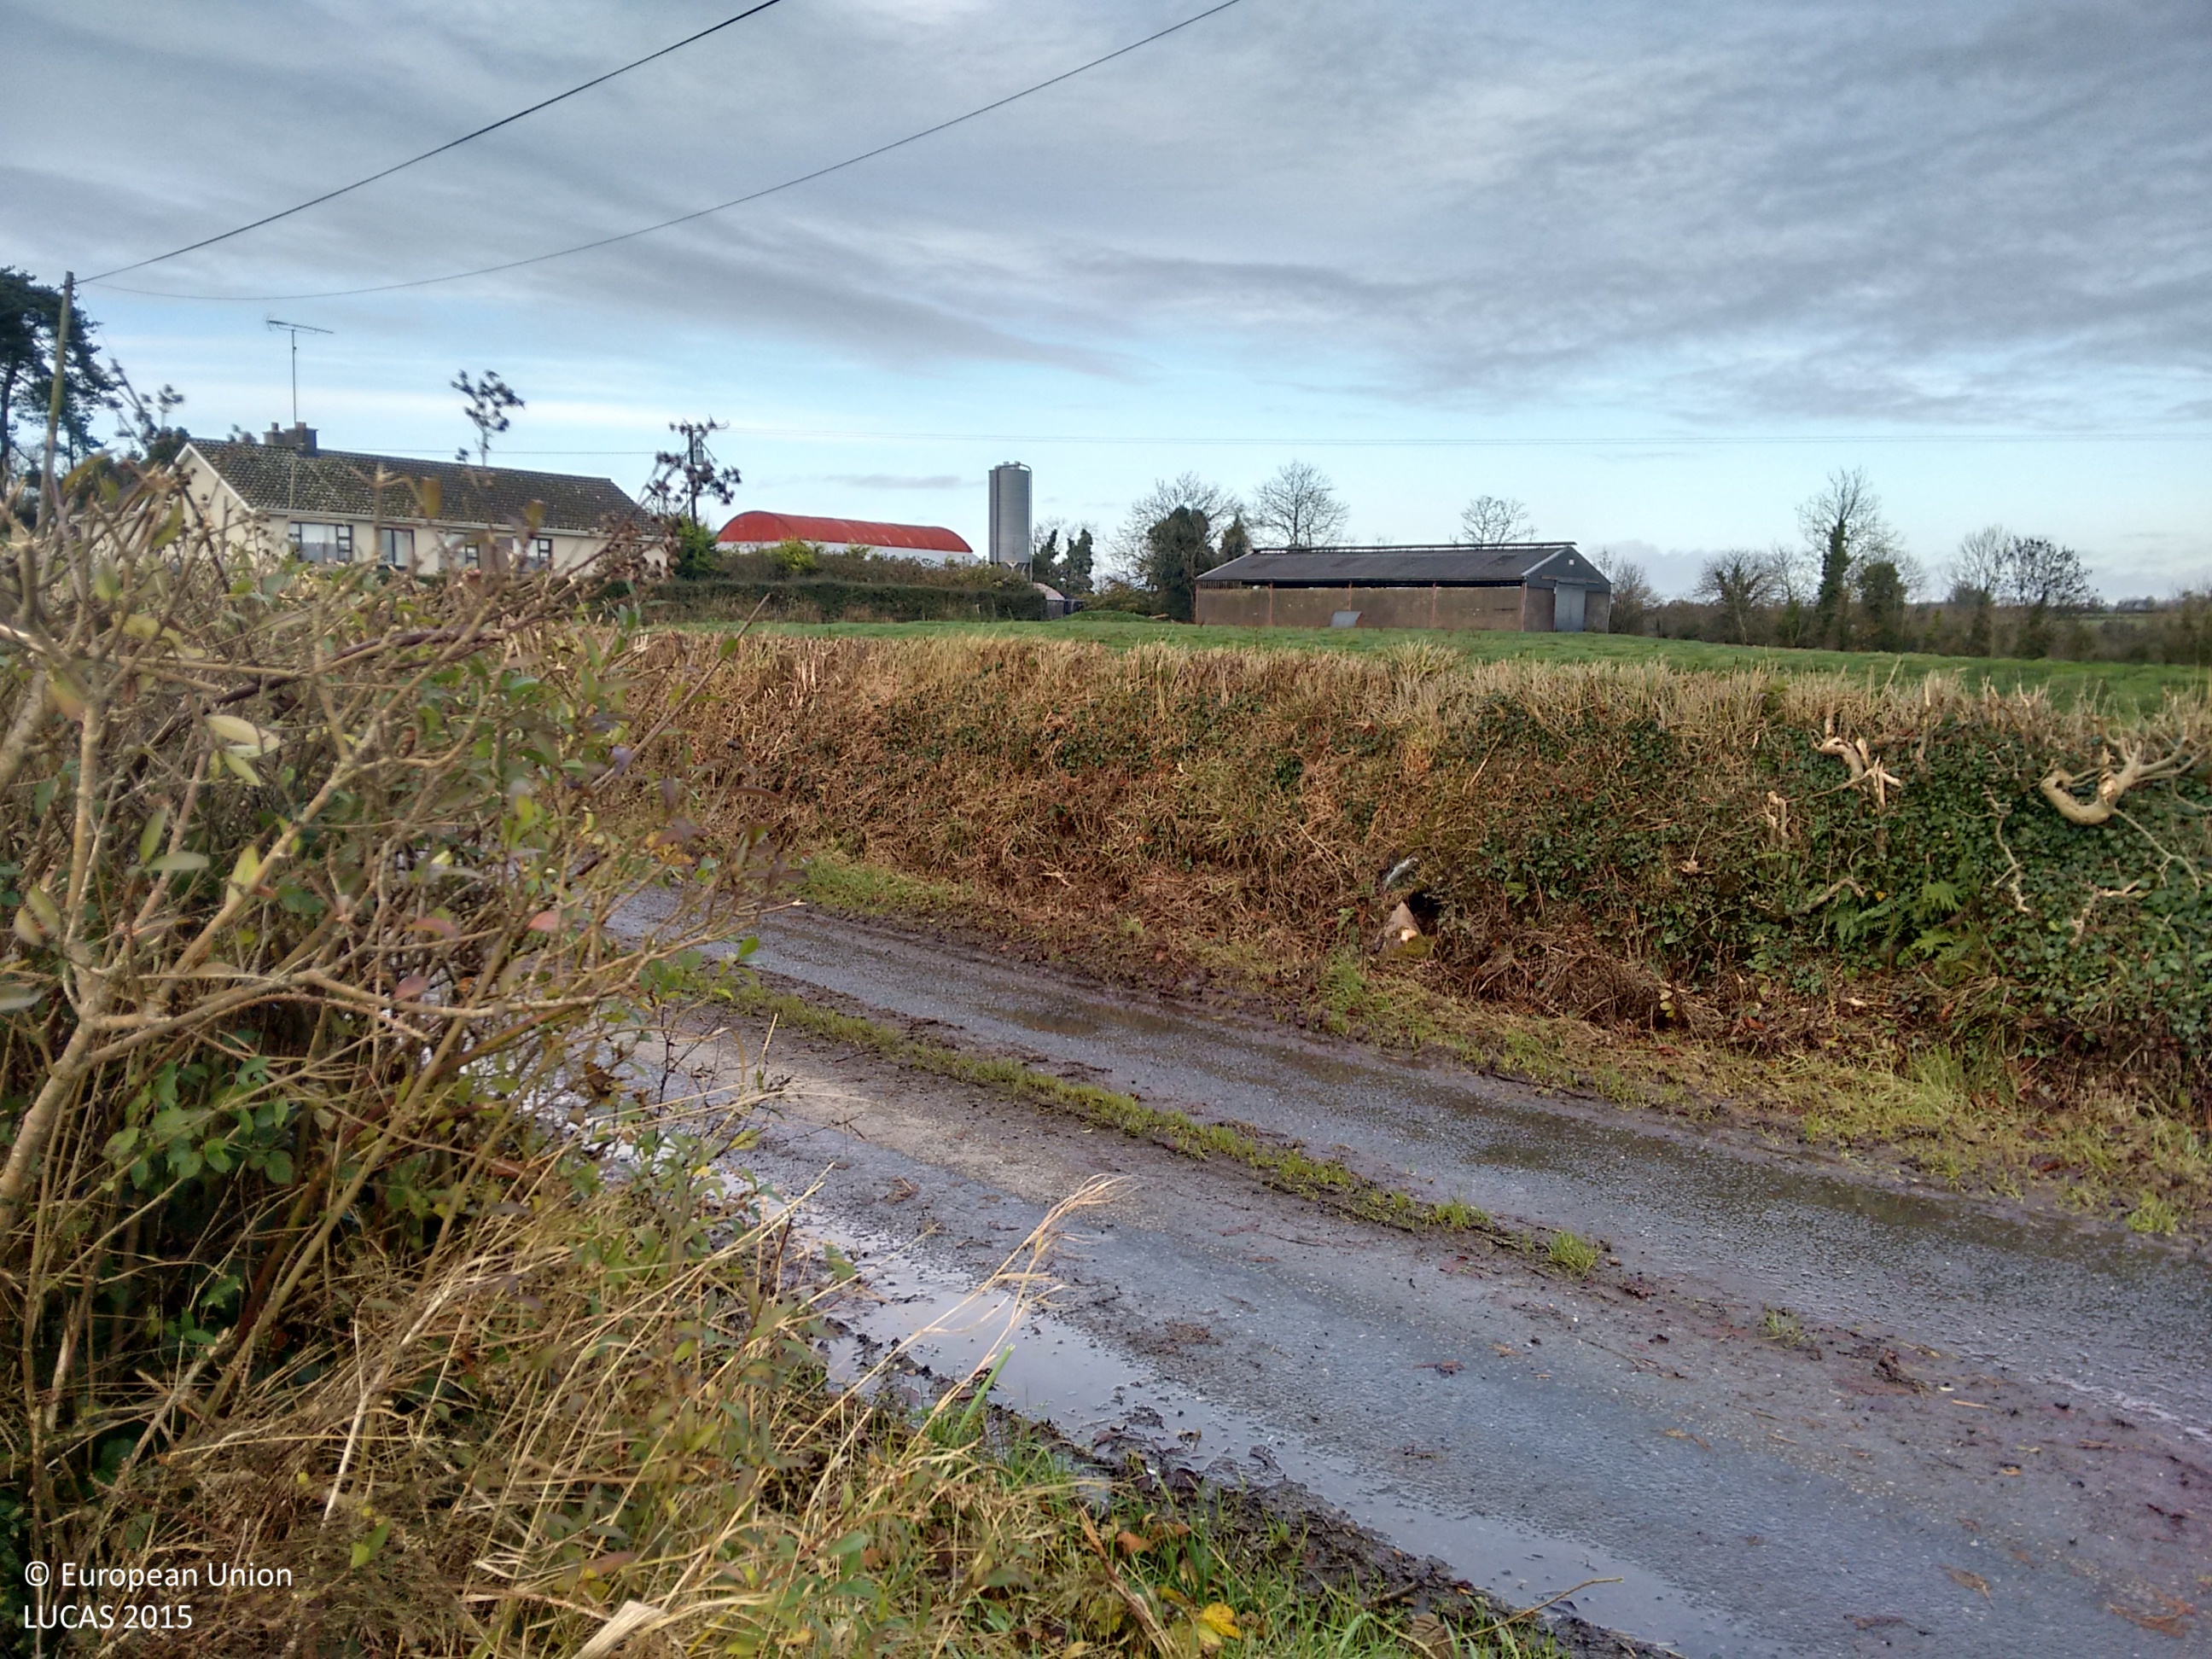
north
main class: Grassland
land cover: Grassland without tree/shrub cover
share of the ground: > 75 %
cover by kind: herbaceous plants 100 %
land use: Agriculture (excluding fallow land and kitchen gardens)
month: November
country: IE
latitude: 53.7671
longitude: -7.7806
